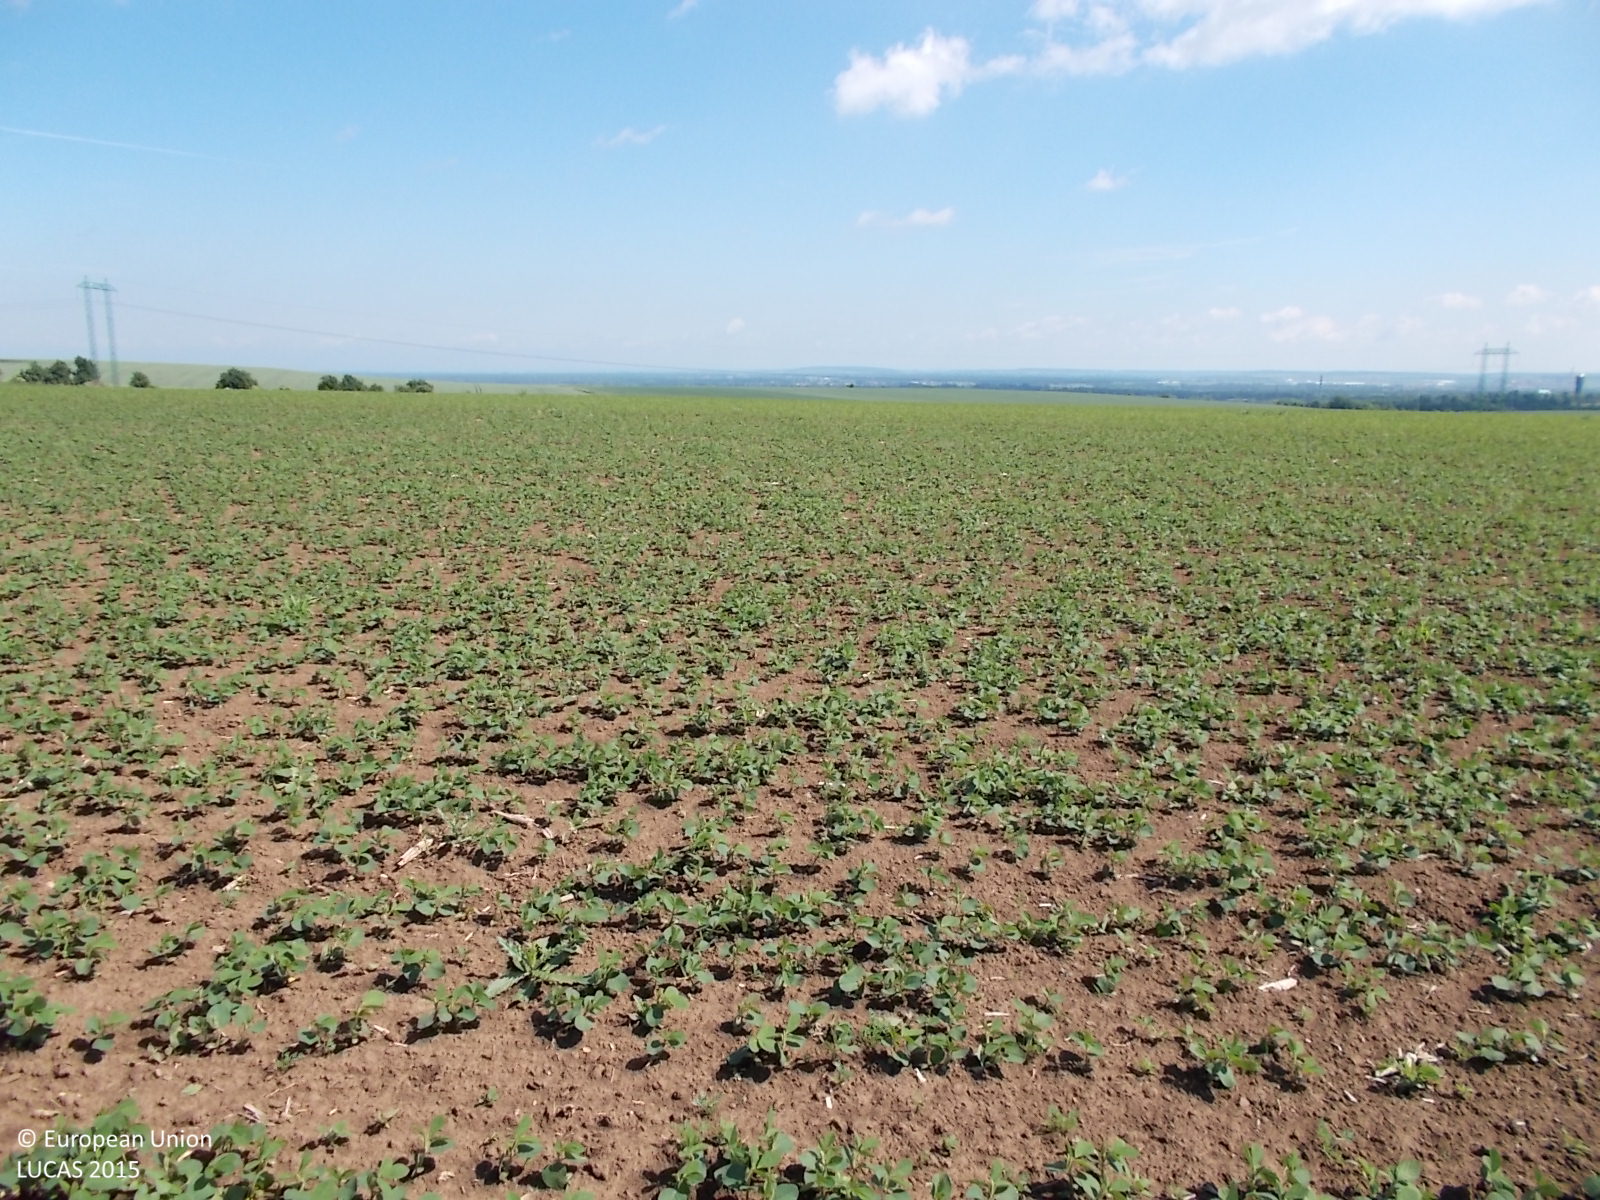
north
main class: Cropland
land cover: Soya
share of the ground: 25 - 50 %
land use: Agriculture (excluding fallow land and kitchen gardens)
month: June
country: CZ
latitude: 50.0137
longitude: 15.1525
